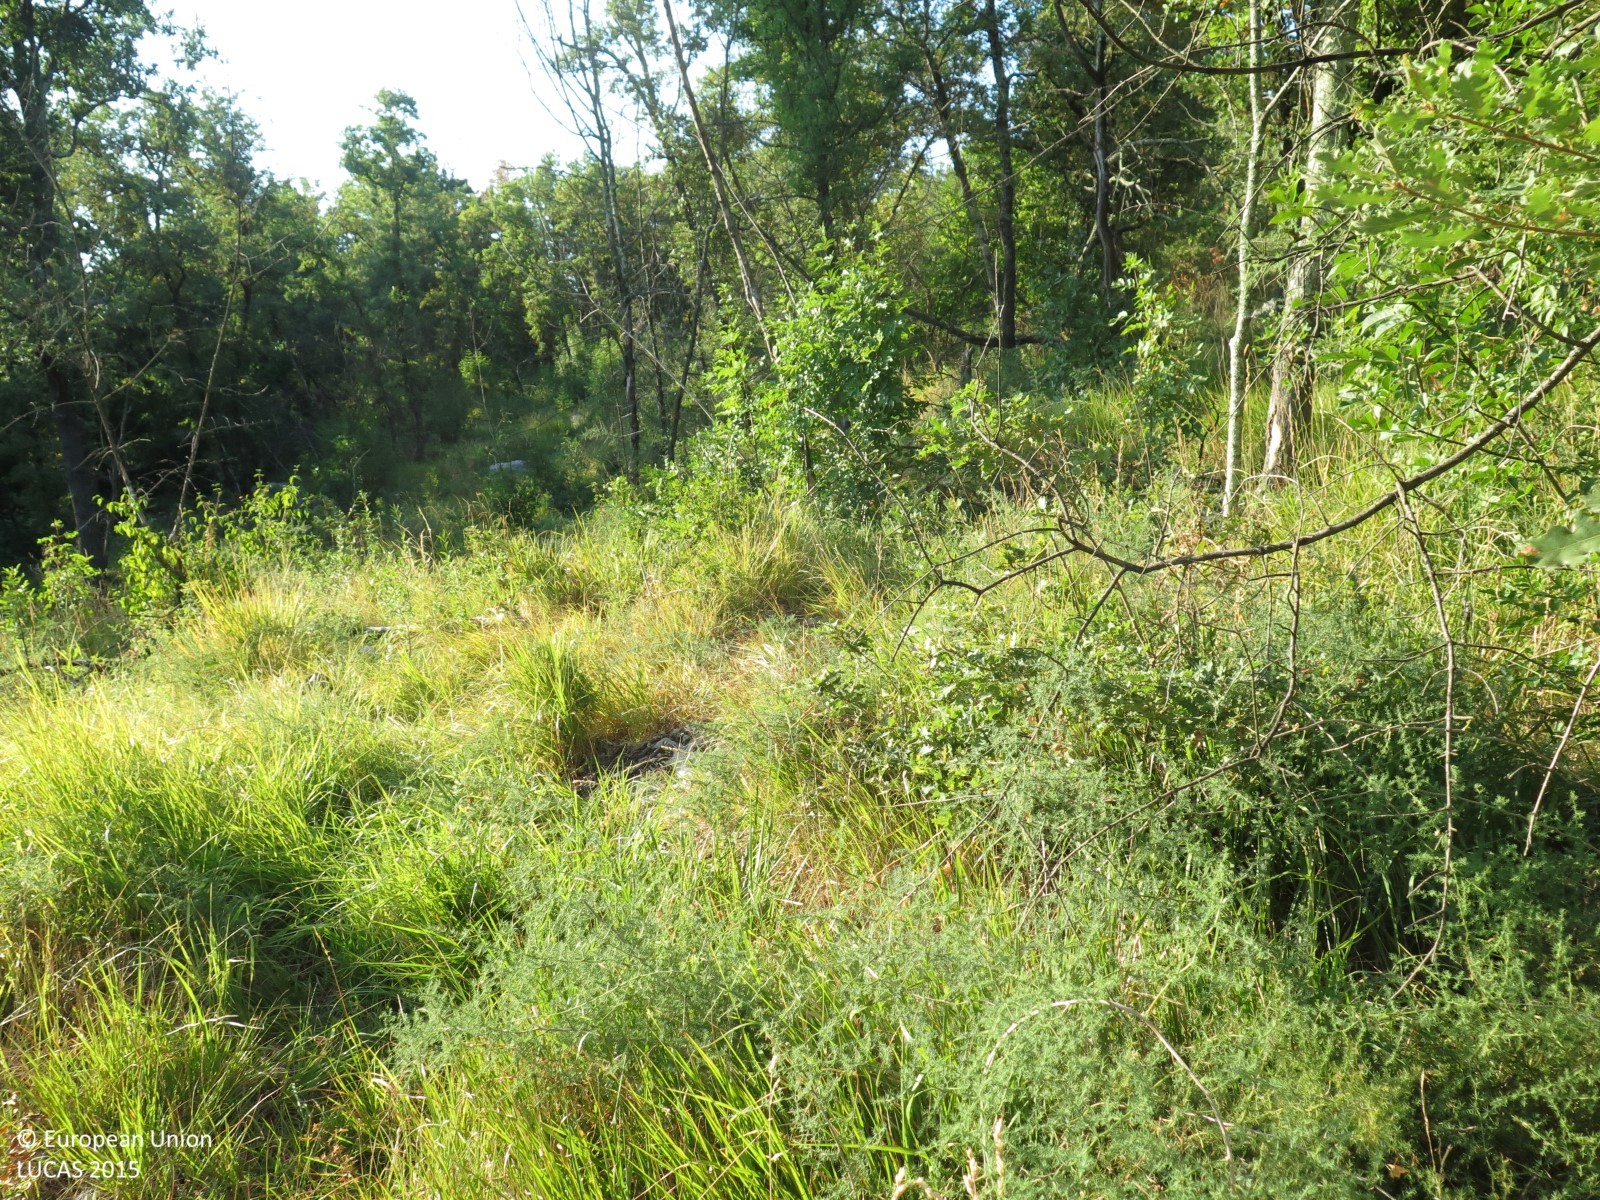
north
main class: Woodland
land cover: Broadleaved woodland
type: acidophilous oak and oak-birch forest
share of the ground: > 75 %
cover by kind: broadleaved forest trees 90 %, herbaceous plants 10 %
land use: Semi-natural and natural areas not in use
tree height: > 5 m
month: July
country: HR
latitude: 45.3539
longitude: 14.0669
